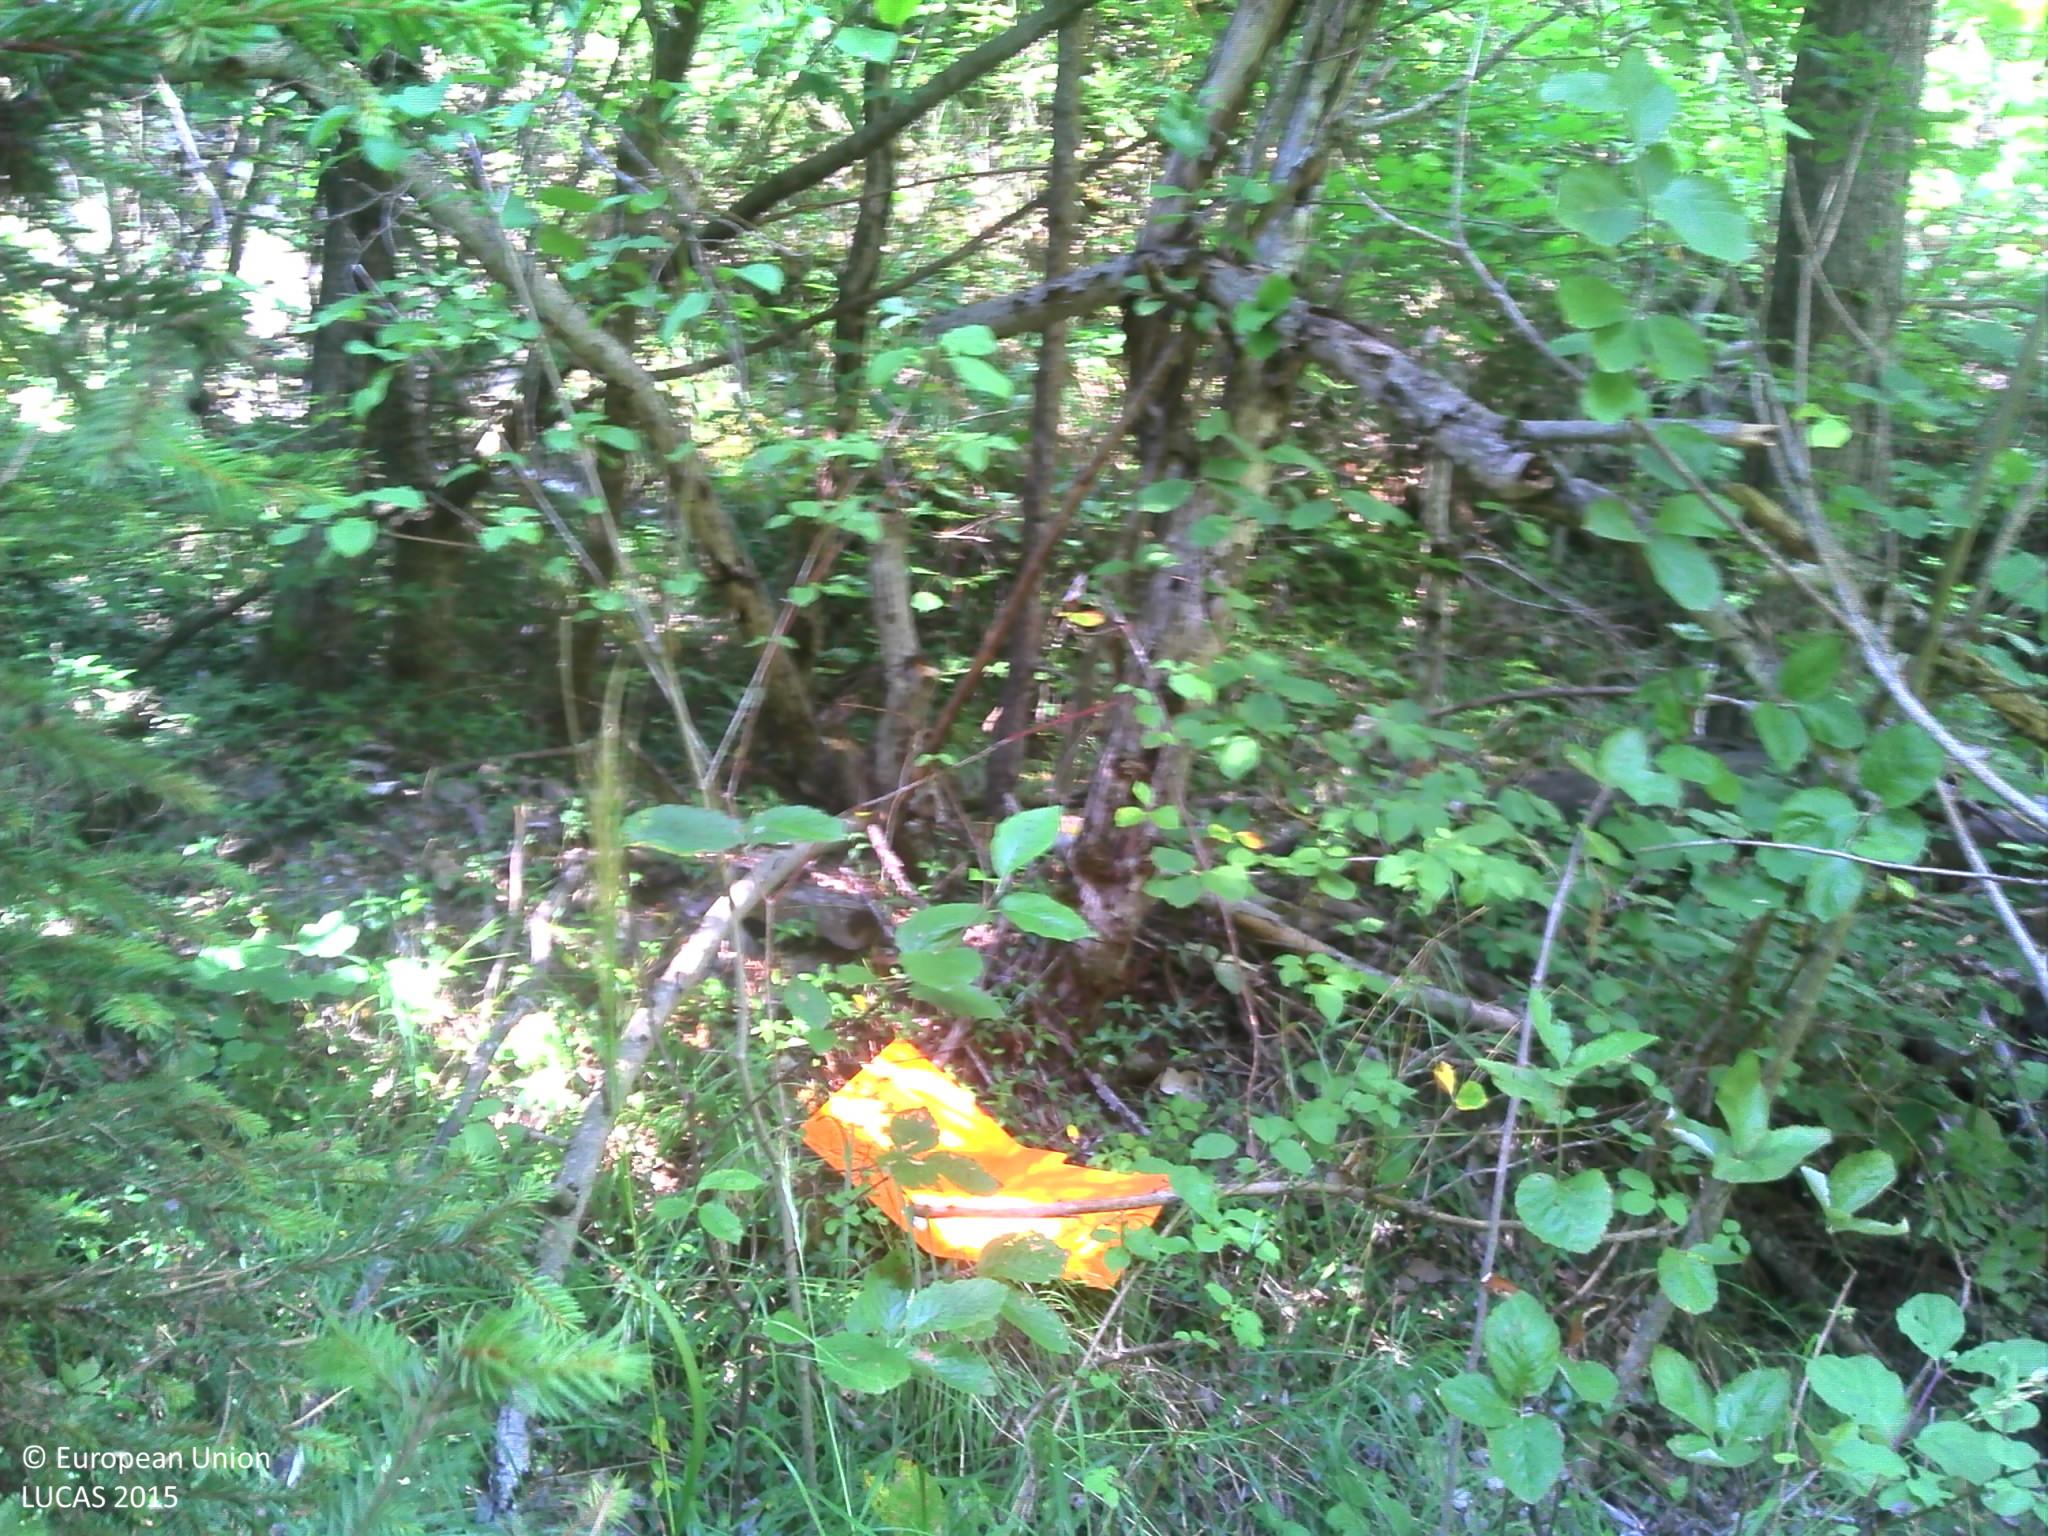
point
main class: Woodland
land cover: Pine dominated mixed woodland
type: alpine coniferous forest
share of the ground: > 75 %
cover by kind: coniferous forest trees 40 %, broadleaved forest trees 40 %, shrubs 10 %, herbaceous plants 10 %
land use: Forestry
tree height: > 5 m
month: August
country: FR
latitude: 44.3845
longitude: 6.5798
